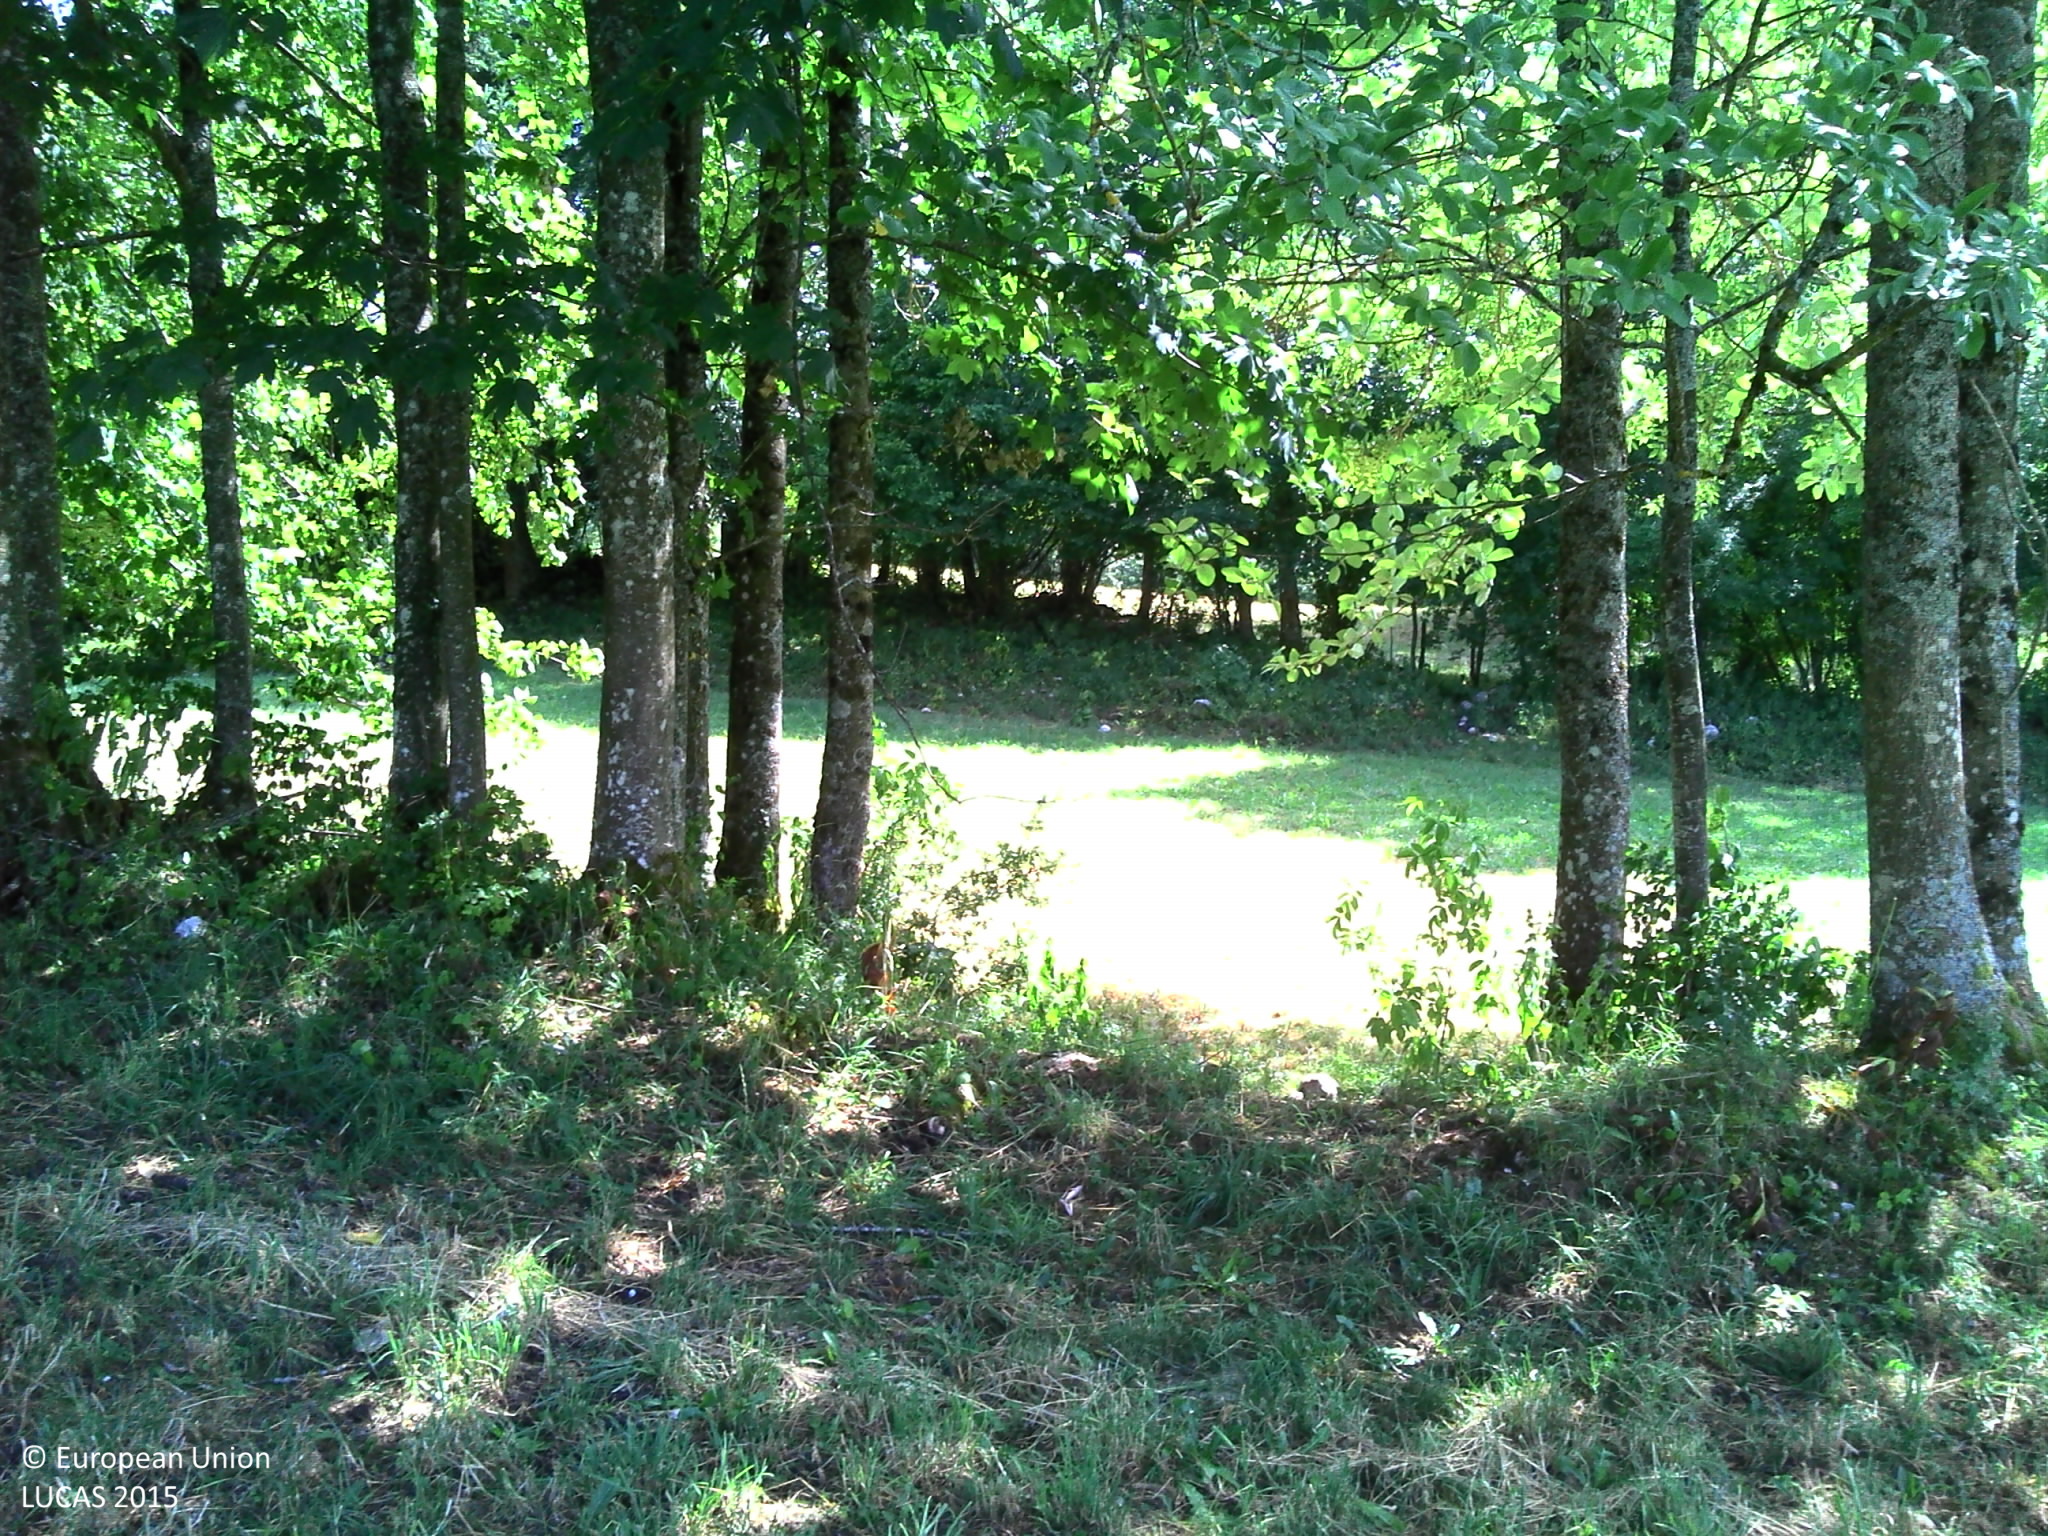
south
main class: Grassland
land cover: Grassland without tree/shrub cover
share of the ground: > 75 %
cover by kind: herbaceous plants 100 %
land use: Agriculture (excluding fallow land and kitchen gardens)
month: July
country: FR
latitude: 46.7655
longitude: 6.0612
